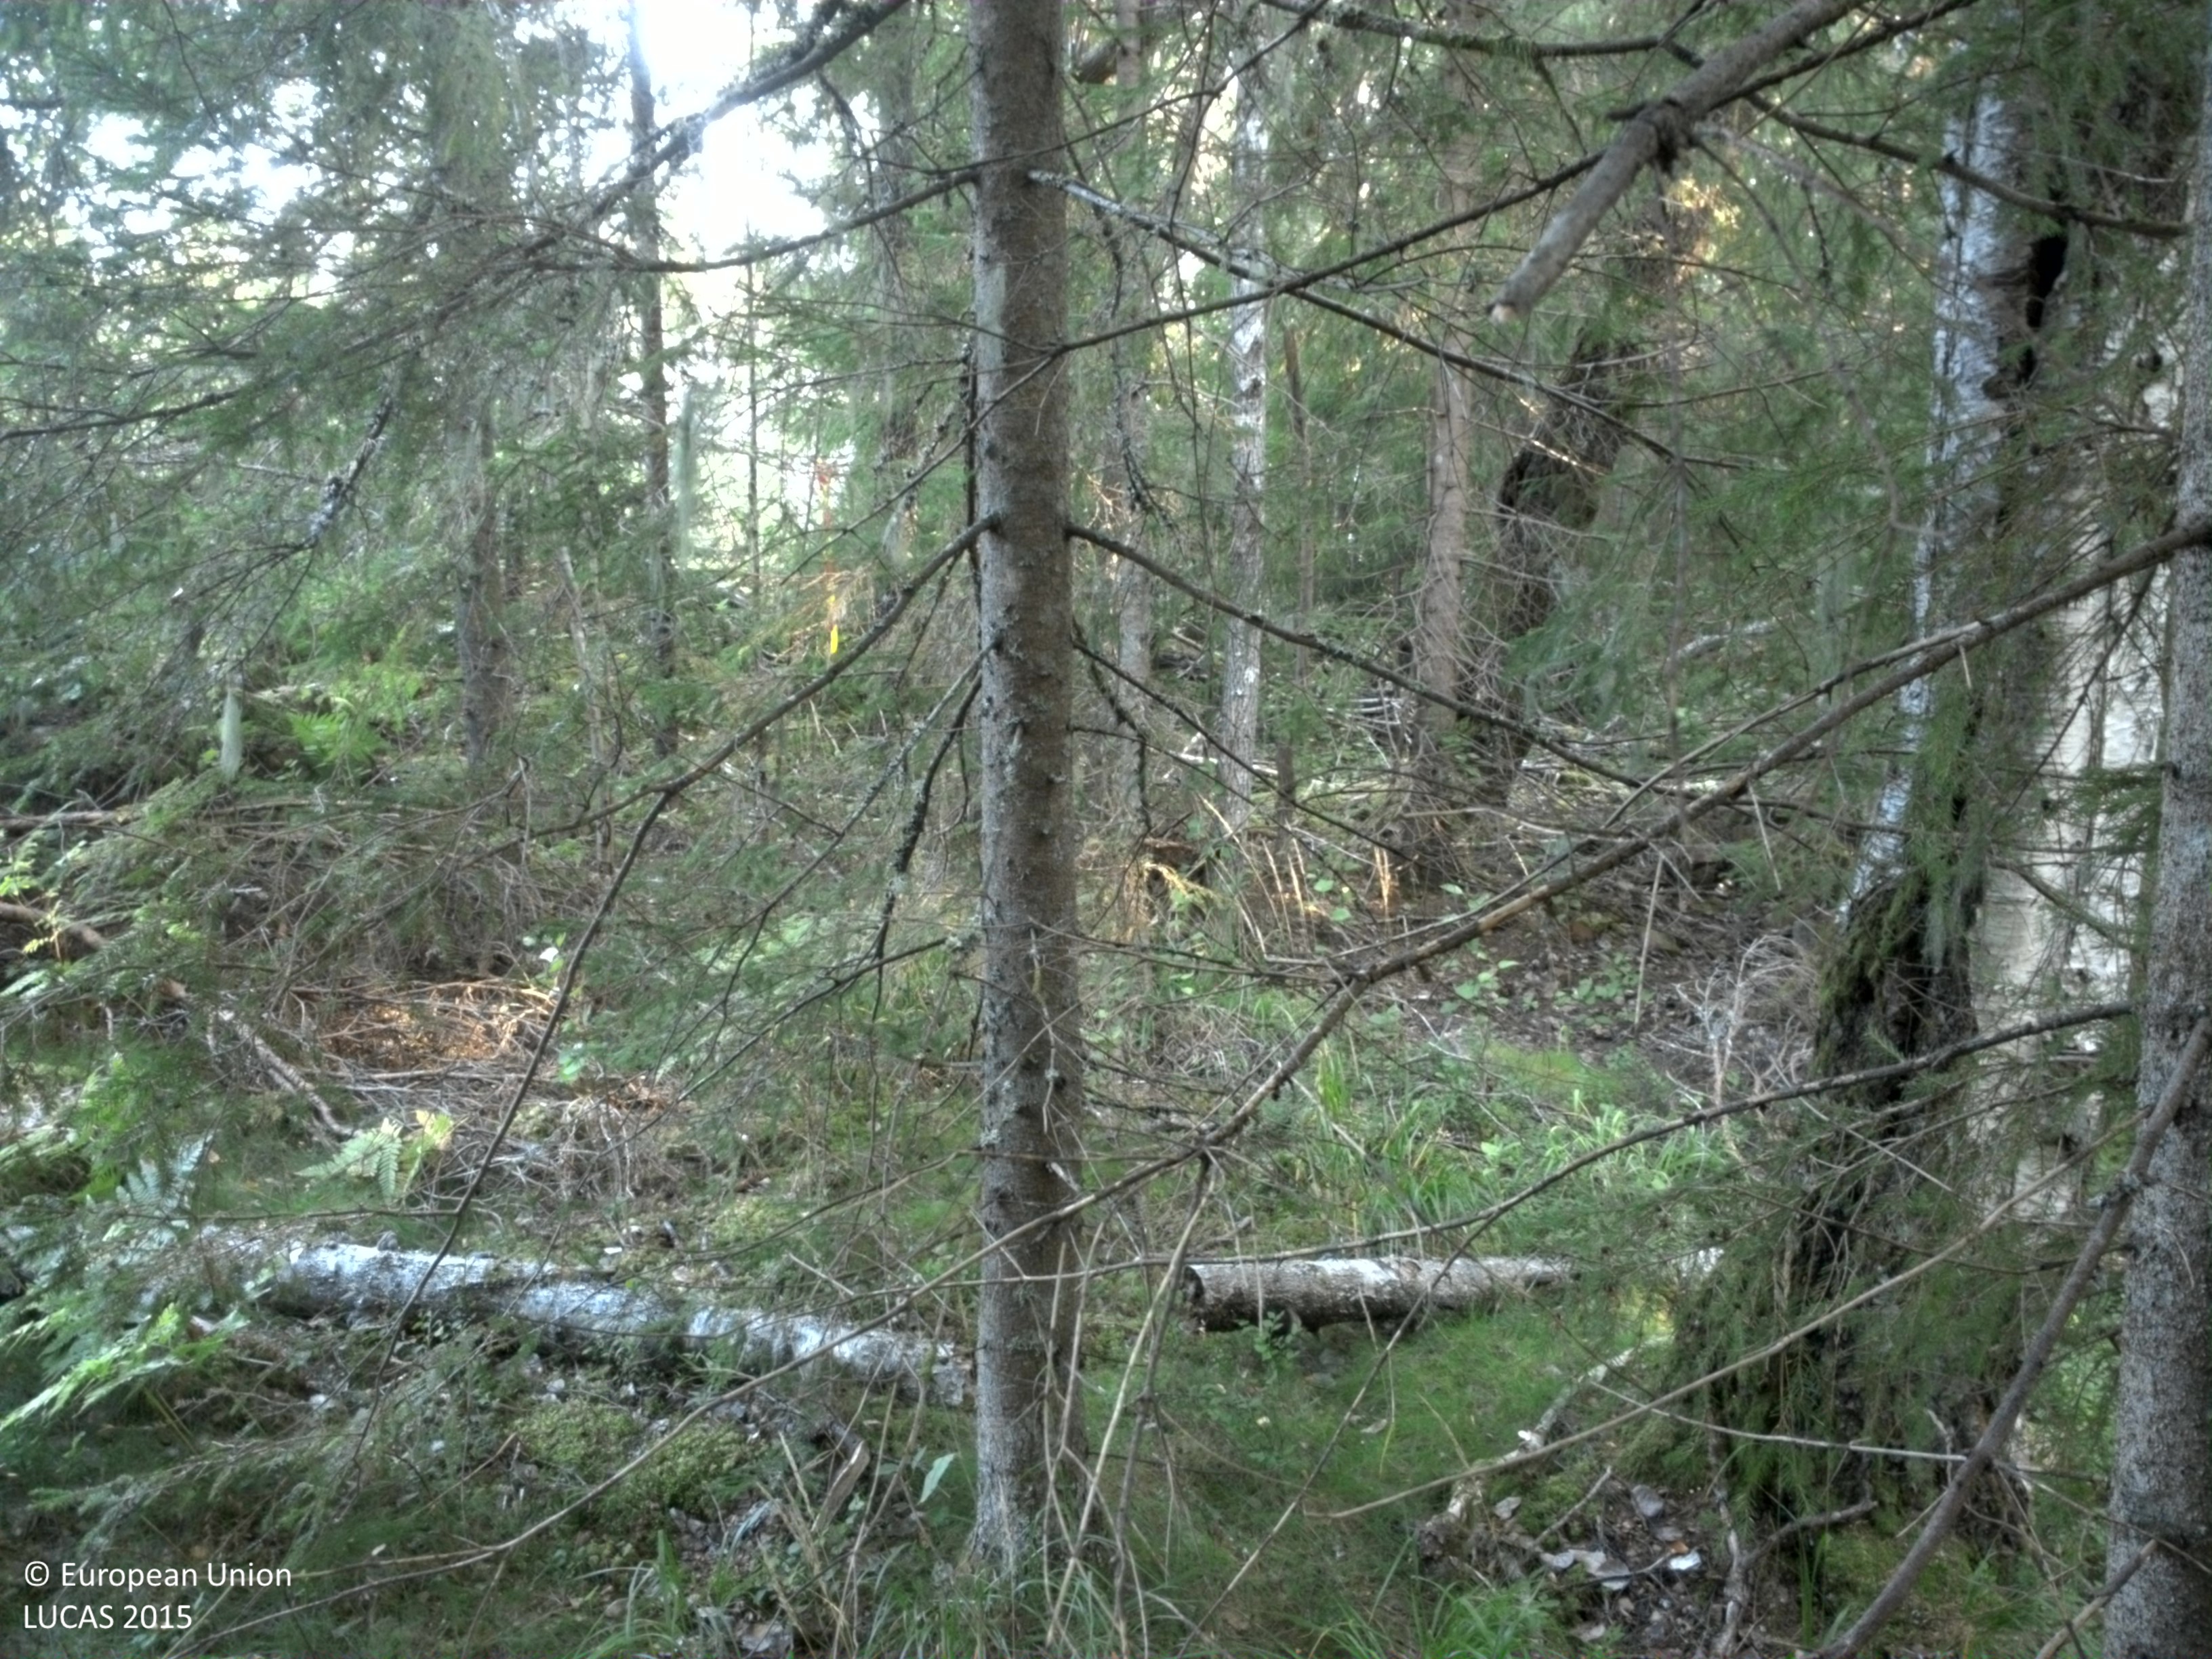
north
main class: Woodland
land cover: Spruce dominated mixed woodland
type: boreal forest
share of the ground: 50 - 75 %
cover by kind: coniferous forest trees 40 %, broadleaved forest trees 30 %, shrubs 15 %, herbaceous plants 15 %
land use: Forestry
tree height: > 5 m
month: August
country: SE
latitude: 59.8437
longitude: 15.8259
